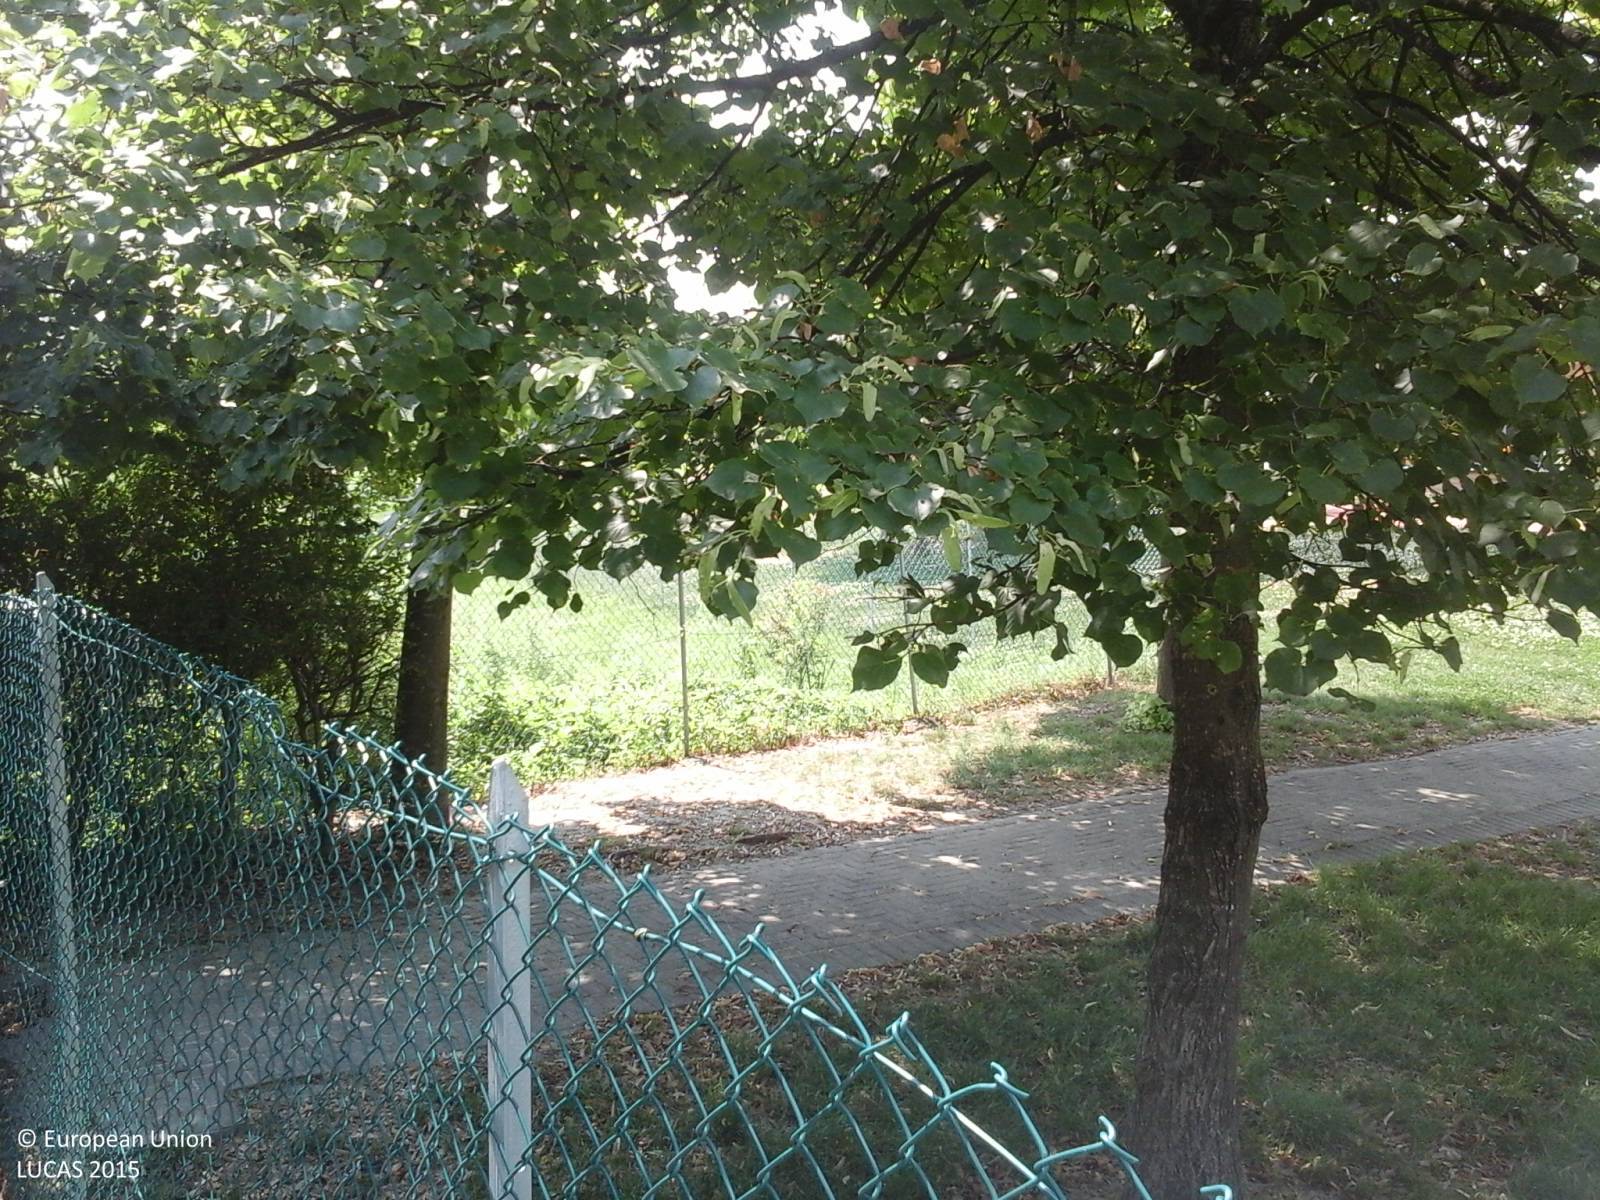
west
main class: Grassland
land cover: Grassland with sparse tree/shrub cover
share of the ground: > 75 %
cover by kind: herbaceous plants 95 %, broadleaved forest trees 5 %
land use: Community services
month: July
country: IT
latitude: 45.9395
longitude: 12.6666
